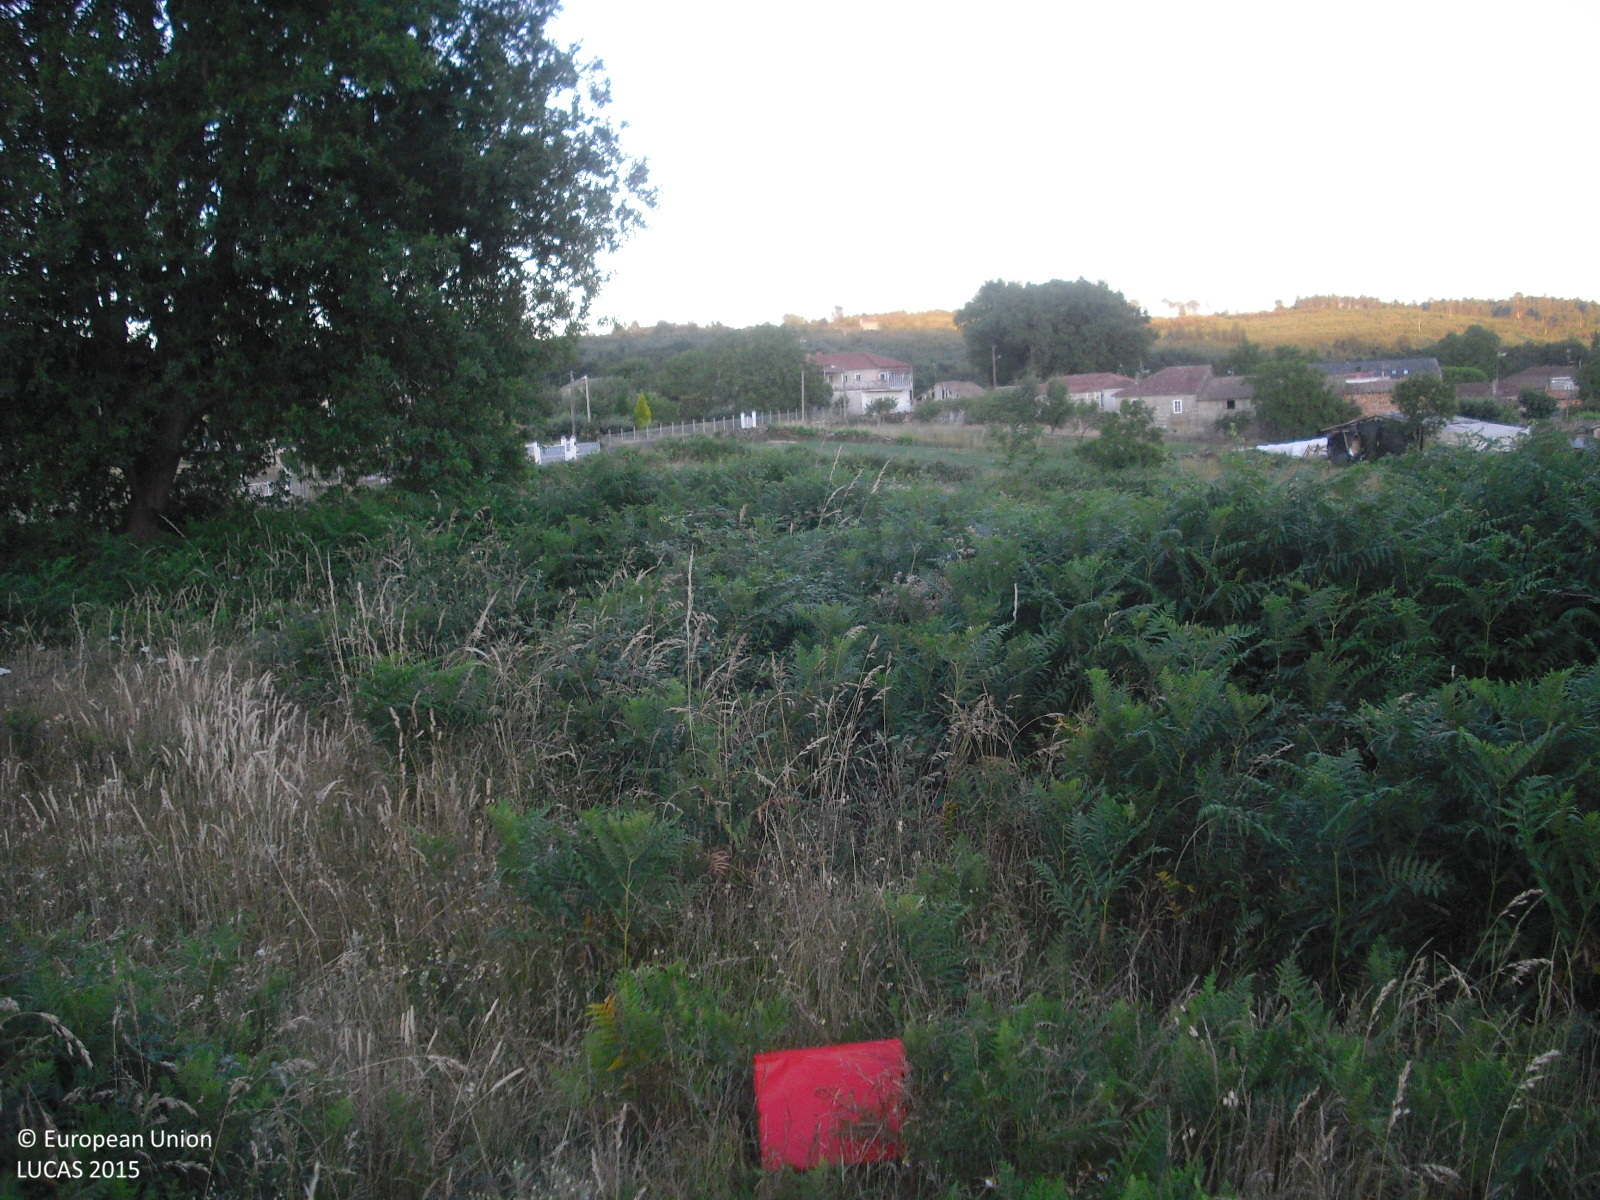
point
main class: Shrubland
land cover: Shrubland without tree cover
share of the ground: 50 - 75 %
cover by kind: shrubs 70 %, herbaceous plants 30 %
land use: Abandoned areas
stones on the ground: 25 - 50 %
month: June
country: ES
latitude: 42.4697
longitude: -7.8731
